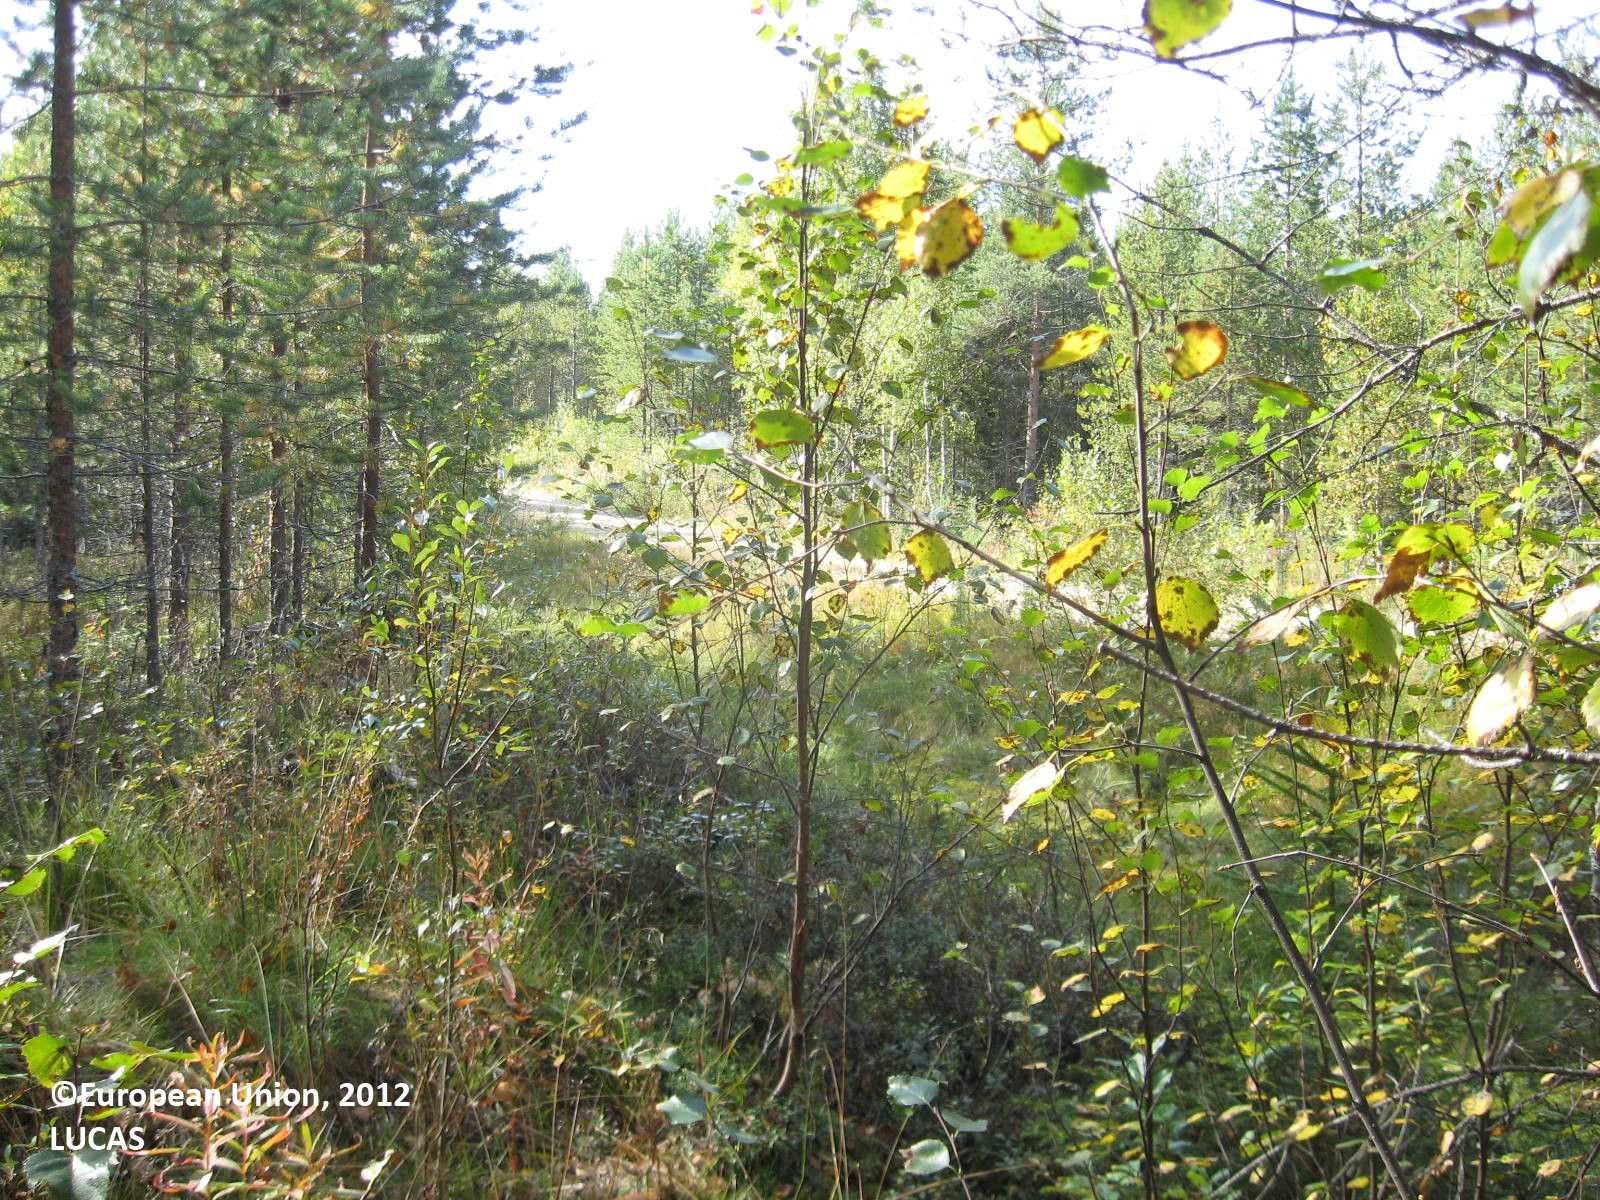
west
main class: Woodland
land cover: Pine dominated mixed woodland
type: boreal forest
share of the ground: > 75 %
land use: Forestry
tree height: > 5 m
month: August
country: FI
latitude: 63.9251
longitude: 28.6854
